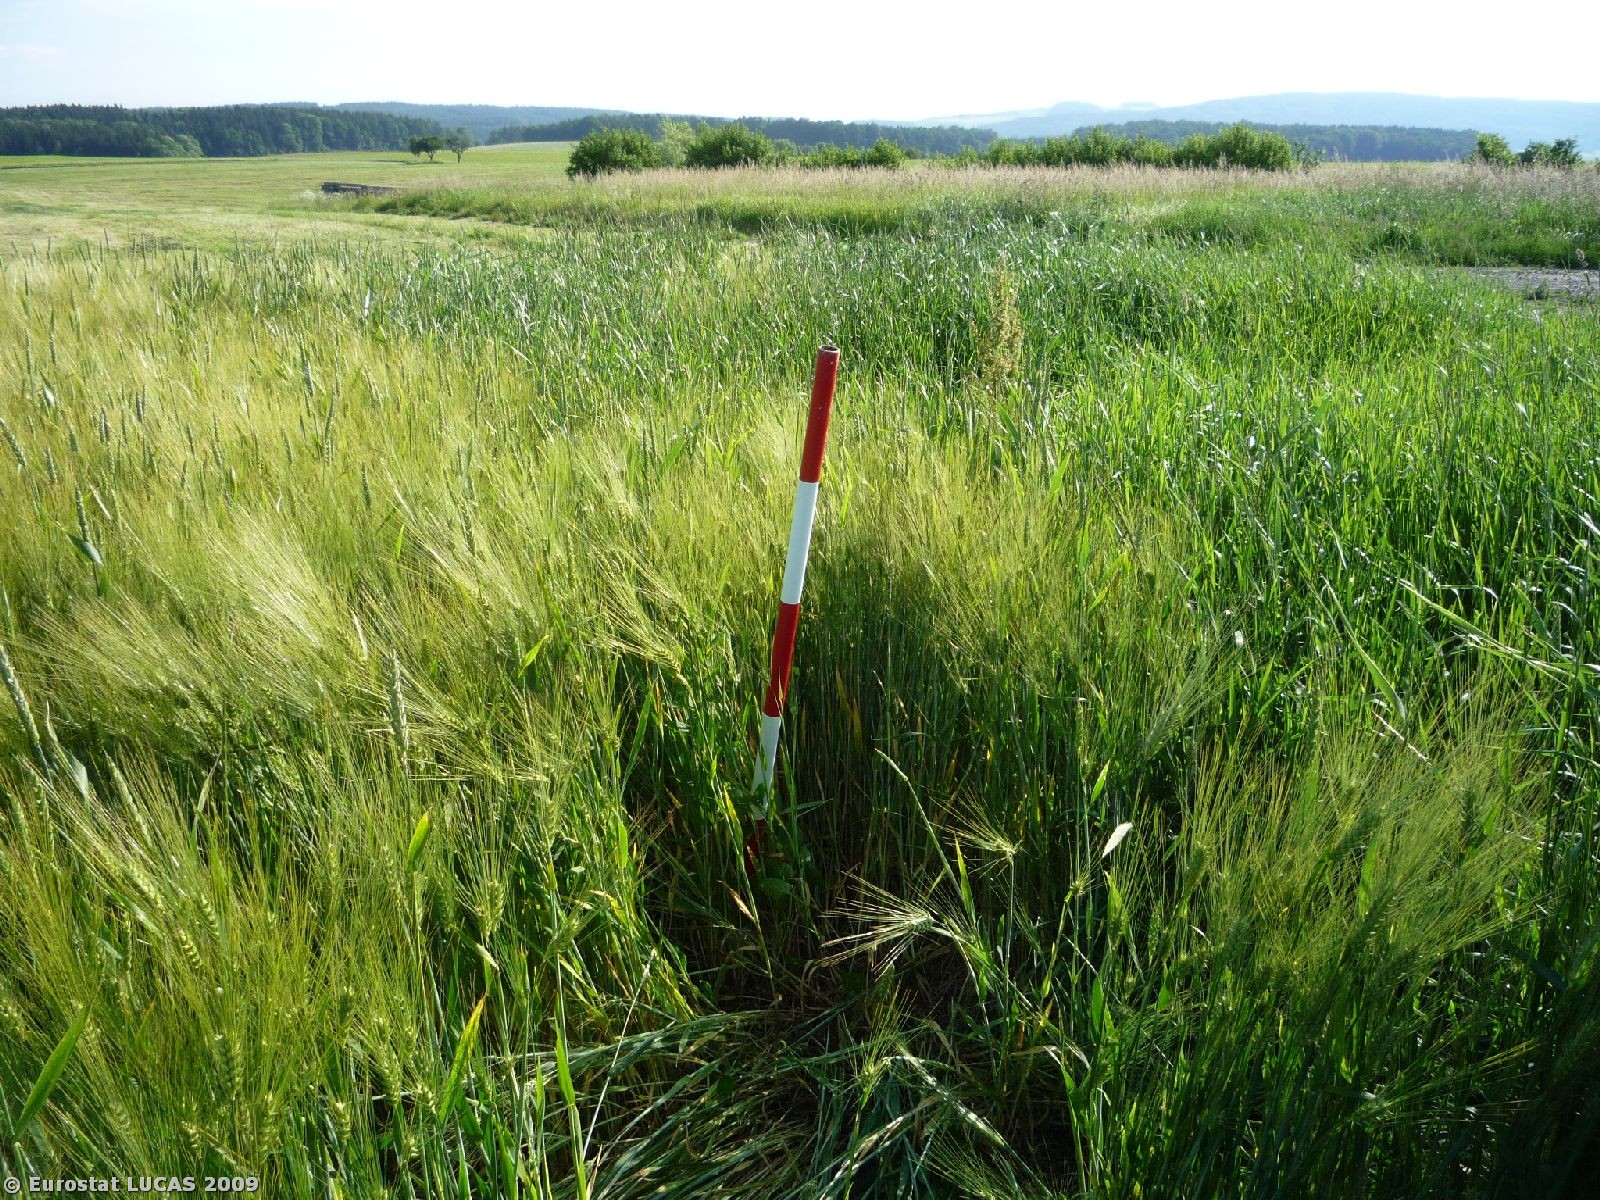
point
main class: Cropland
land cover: Barley
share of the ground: > 75 %
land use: Agriculture (excluding fallow land and kitchen gardens)
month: June
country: CZ
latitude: 50.4283
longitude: 15.5365
